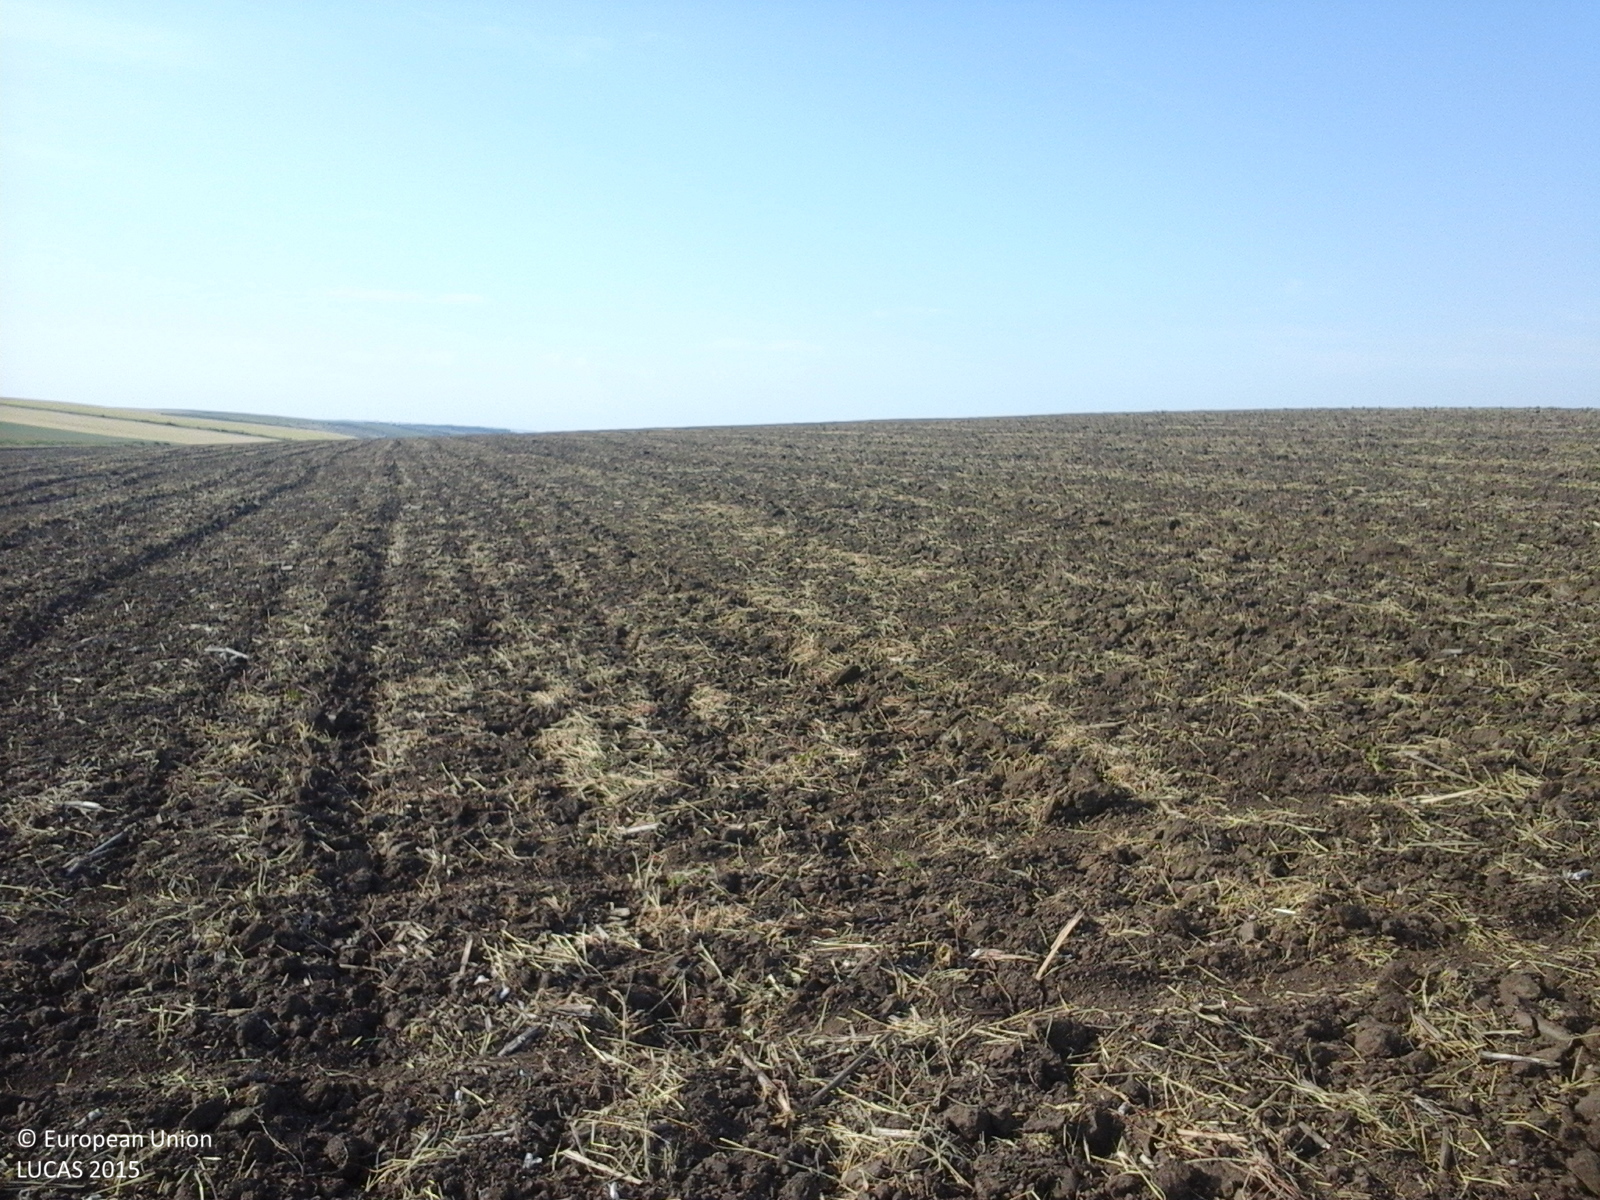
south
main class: Cropland
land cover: Common wheat
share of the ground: < 10 %
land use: Agriculture (excluding fallow land and kitchen gardens)
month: July
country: RO
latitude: 46.0045
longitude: 27.7943
